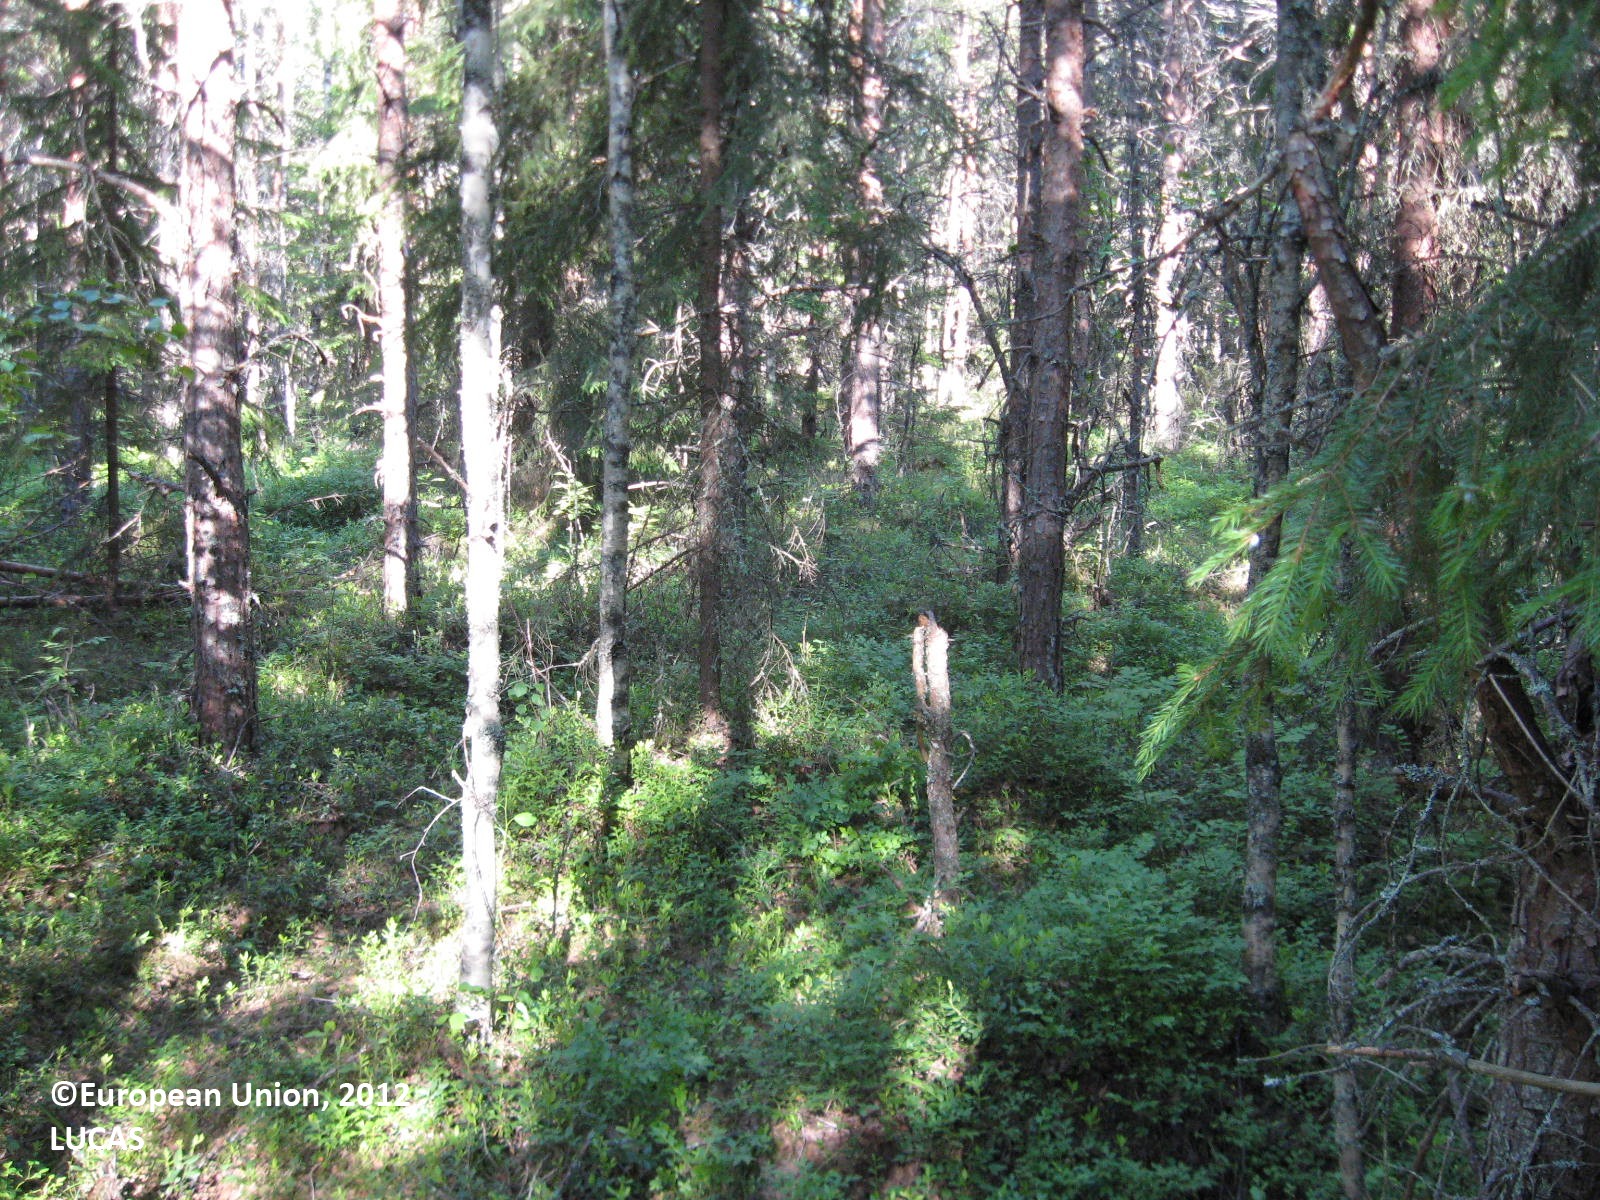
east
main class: Woodland
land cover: Spruce dominated mixed woodland
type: boreal forest
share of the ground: > 75 %
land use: Forestry
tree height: > 5 m
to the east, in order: Spruce dominated mixed woodland; Pine dominated coniferous woodland; Spruce dominated mixed woodland; Grass margins; Paved roads, cycling and walking lanes; Grass margins; Ditches and canals; Pine dominated coniferous woodland; Pine dominated mixed woodland
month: June
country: FI
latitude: 62.7490
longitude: 21.5724
